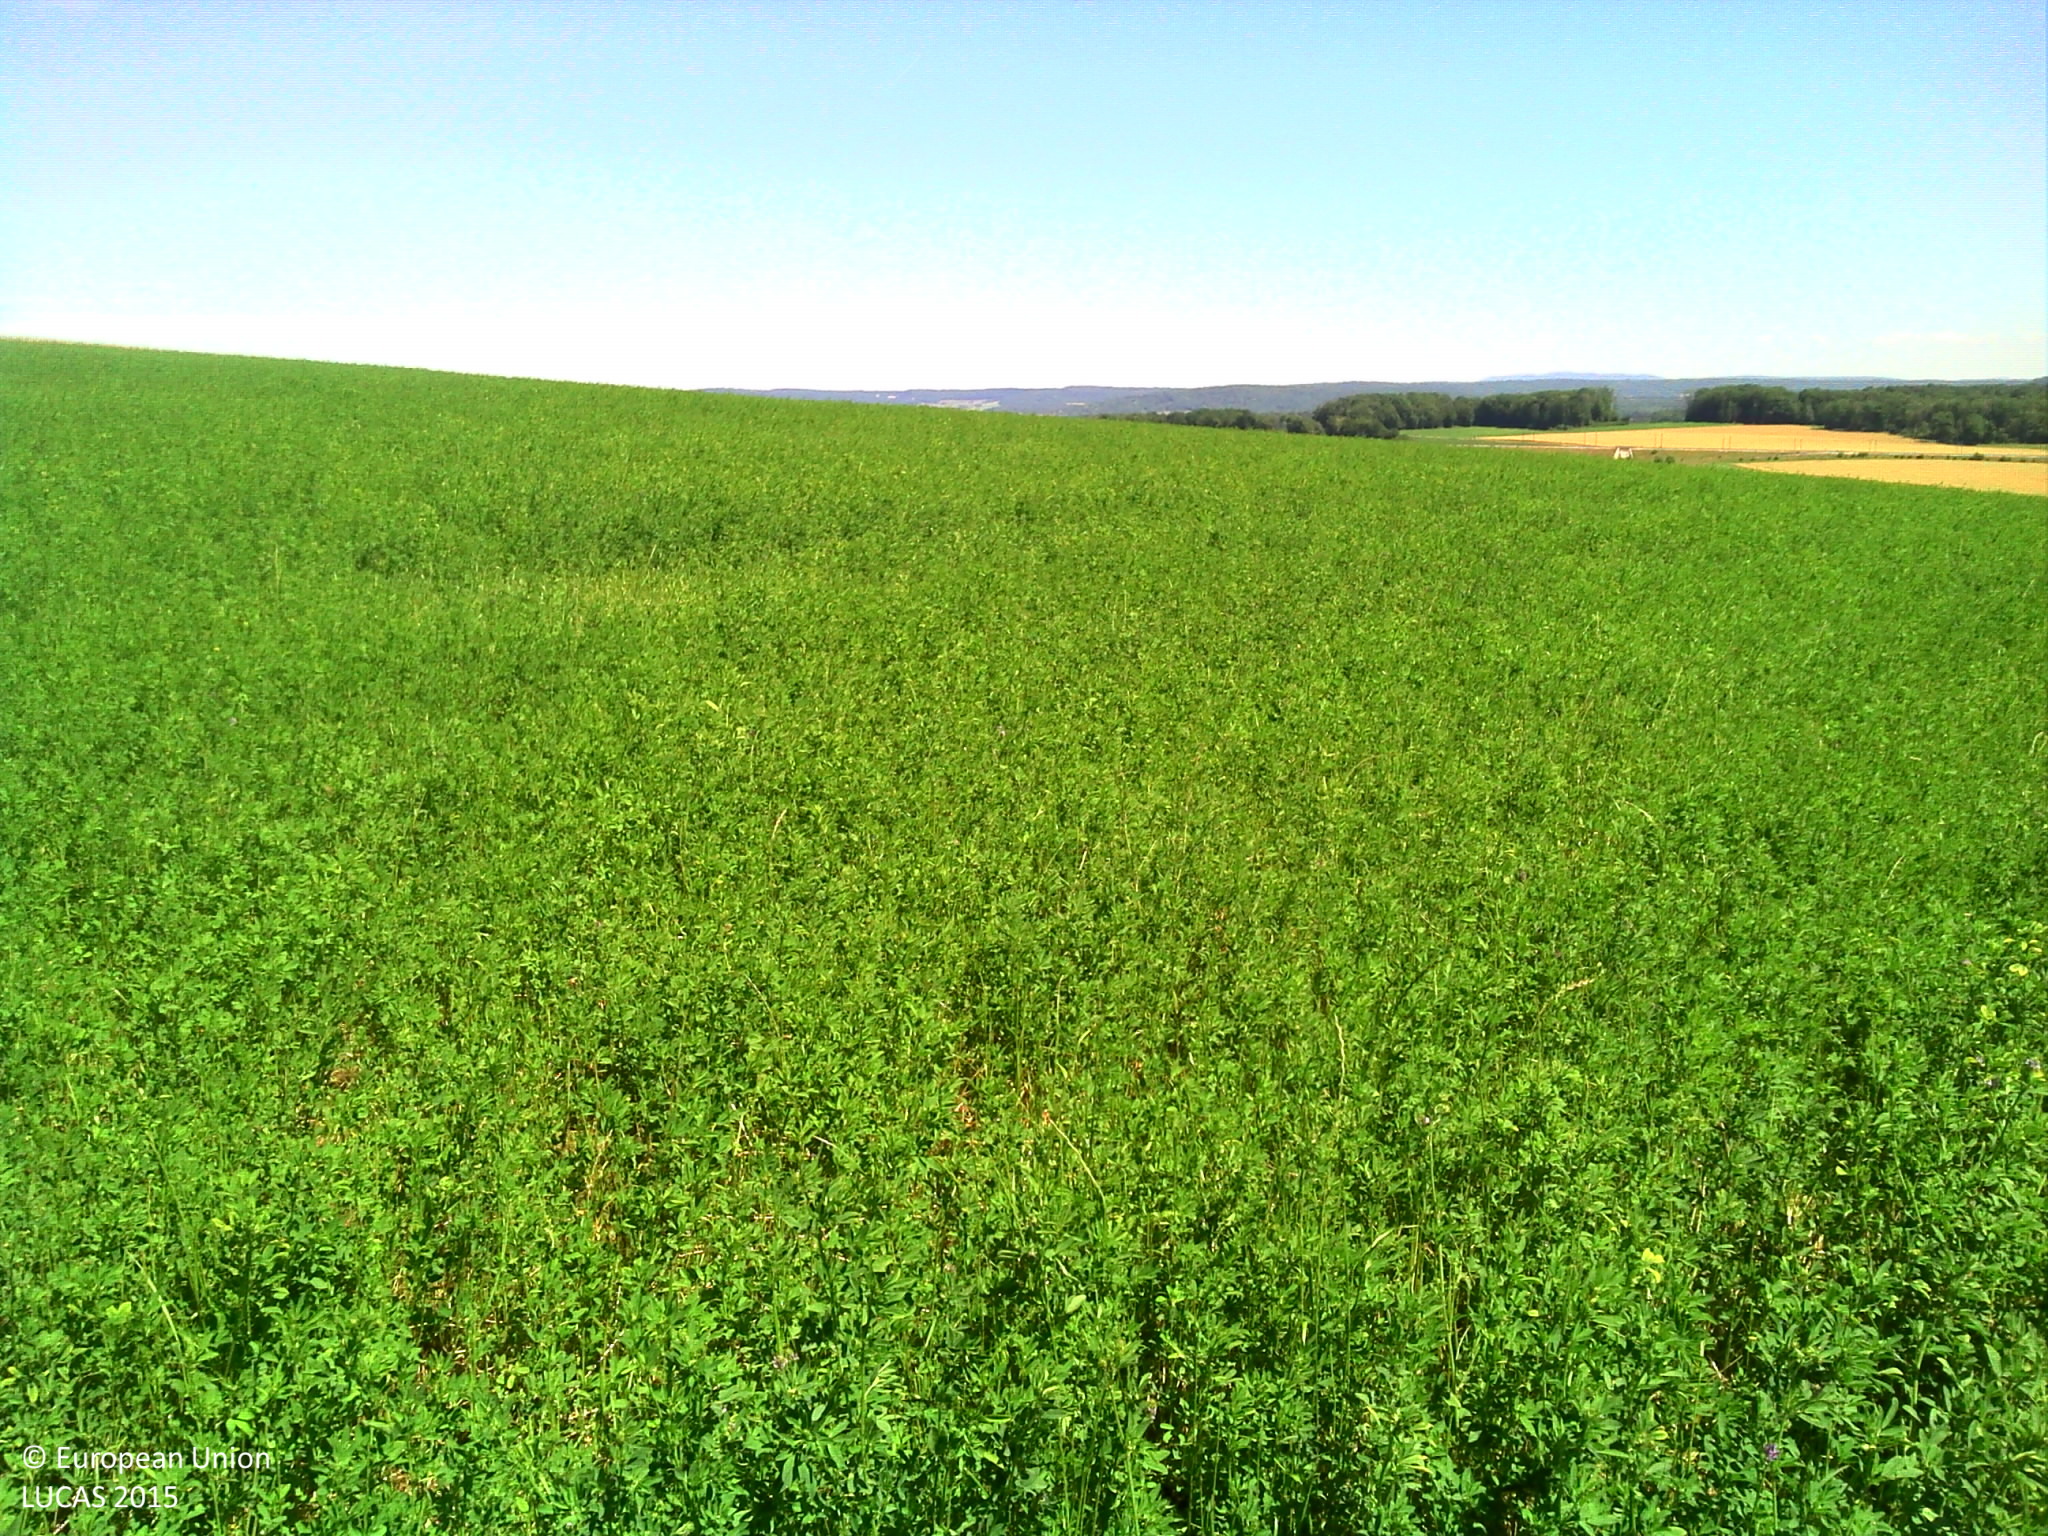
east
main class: Cropland
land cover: Rape and turnip rape
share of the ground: > 75 %
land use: Agriculture (excluding fallow land and kitchen gardens)
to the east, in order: Rape and turnip rape; Grass margins; Lucerne; Rape and turnip rape
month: June
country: FR
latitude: 47.4930
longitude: 6.2451
